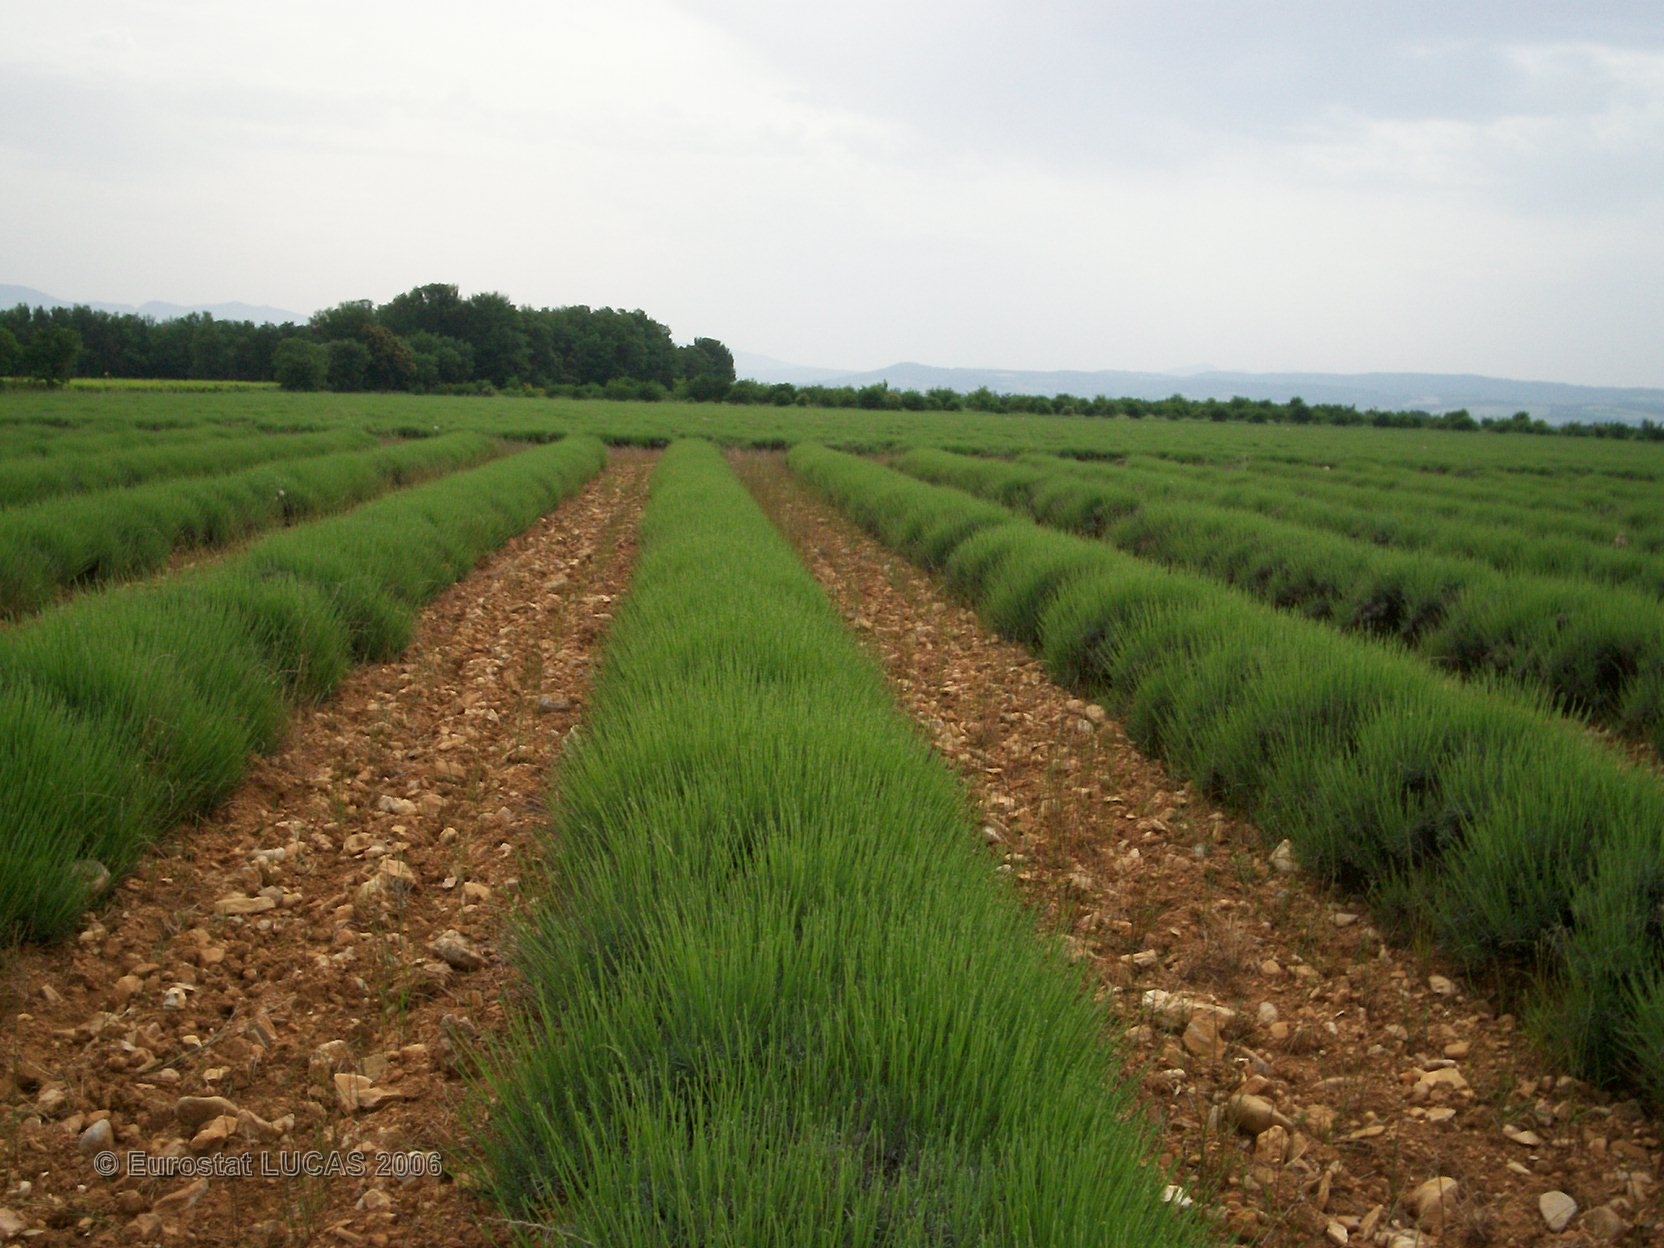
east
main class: Cropland
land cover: Permanent industrial crops
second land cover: Bare land
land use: Agriculture (excluding fallow land and kitchen gardens)
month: May
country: FR
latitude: 44.3709
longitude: 4.9248
